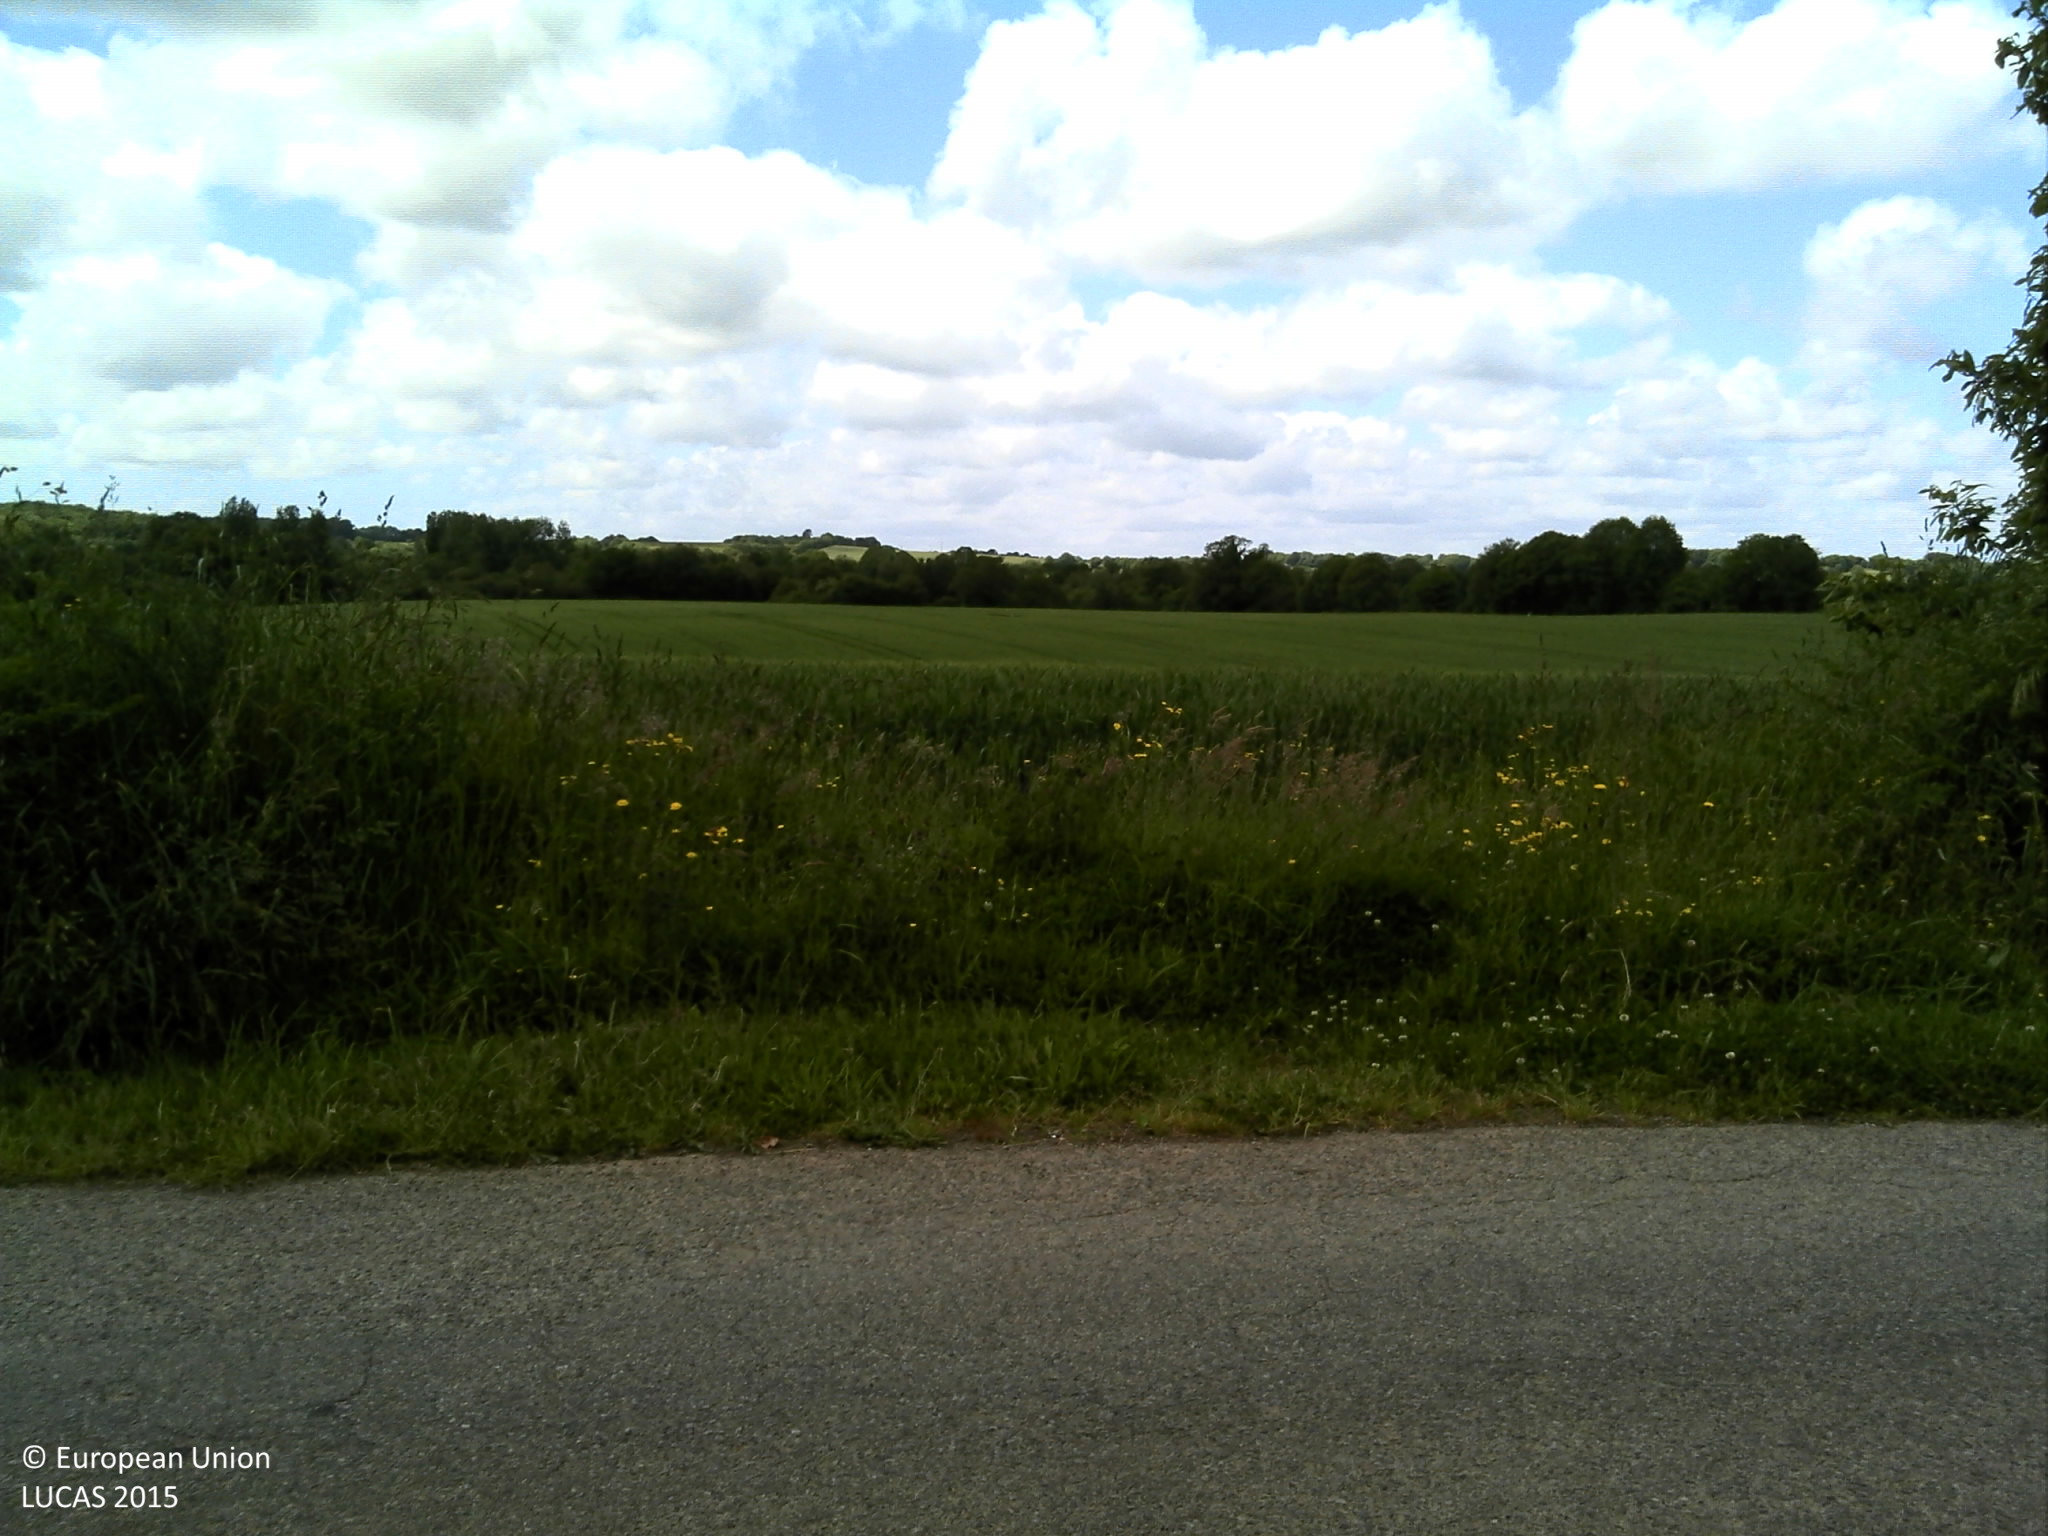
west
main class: Cropland
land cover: Maize
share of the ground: 10 - 25 %
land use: Agriculture (excluding fallow land and kitchen gardens)
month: June
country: FR
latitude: 47.9818
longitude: -3.5695
